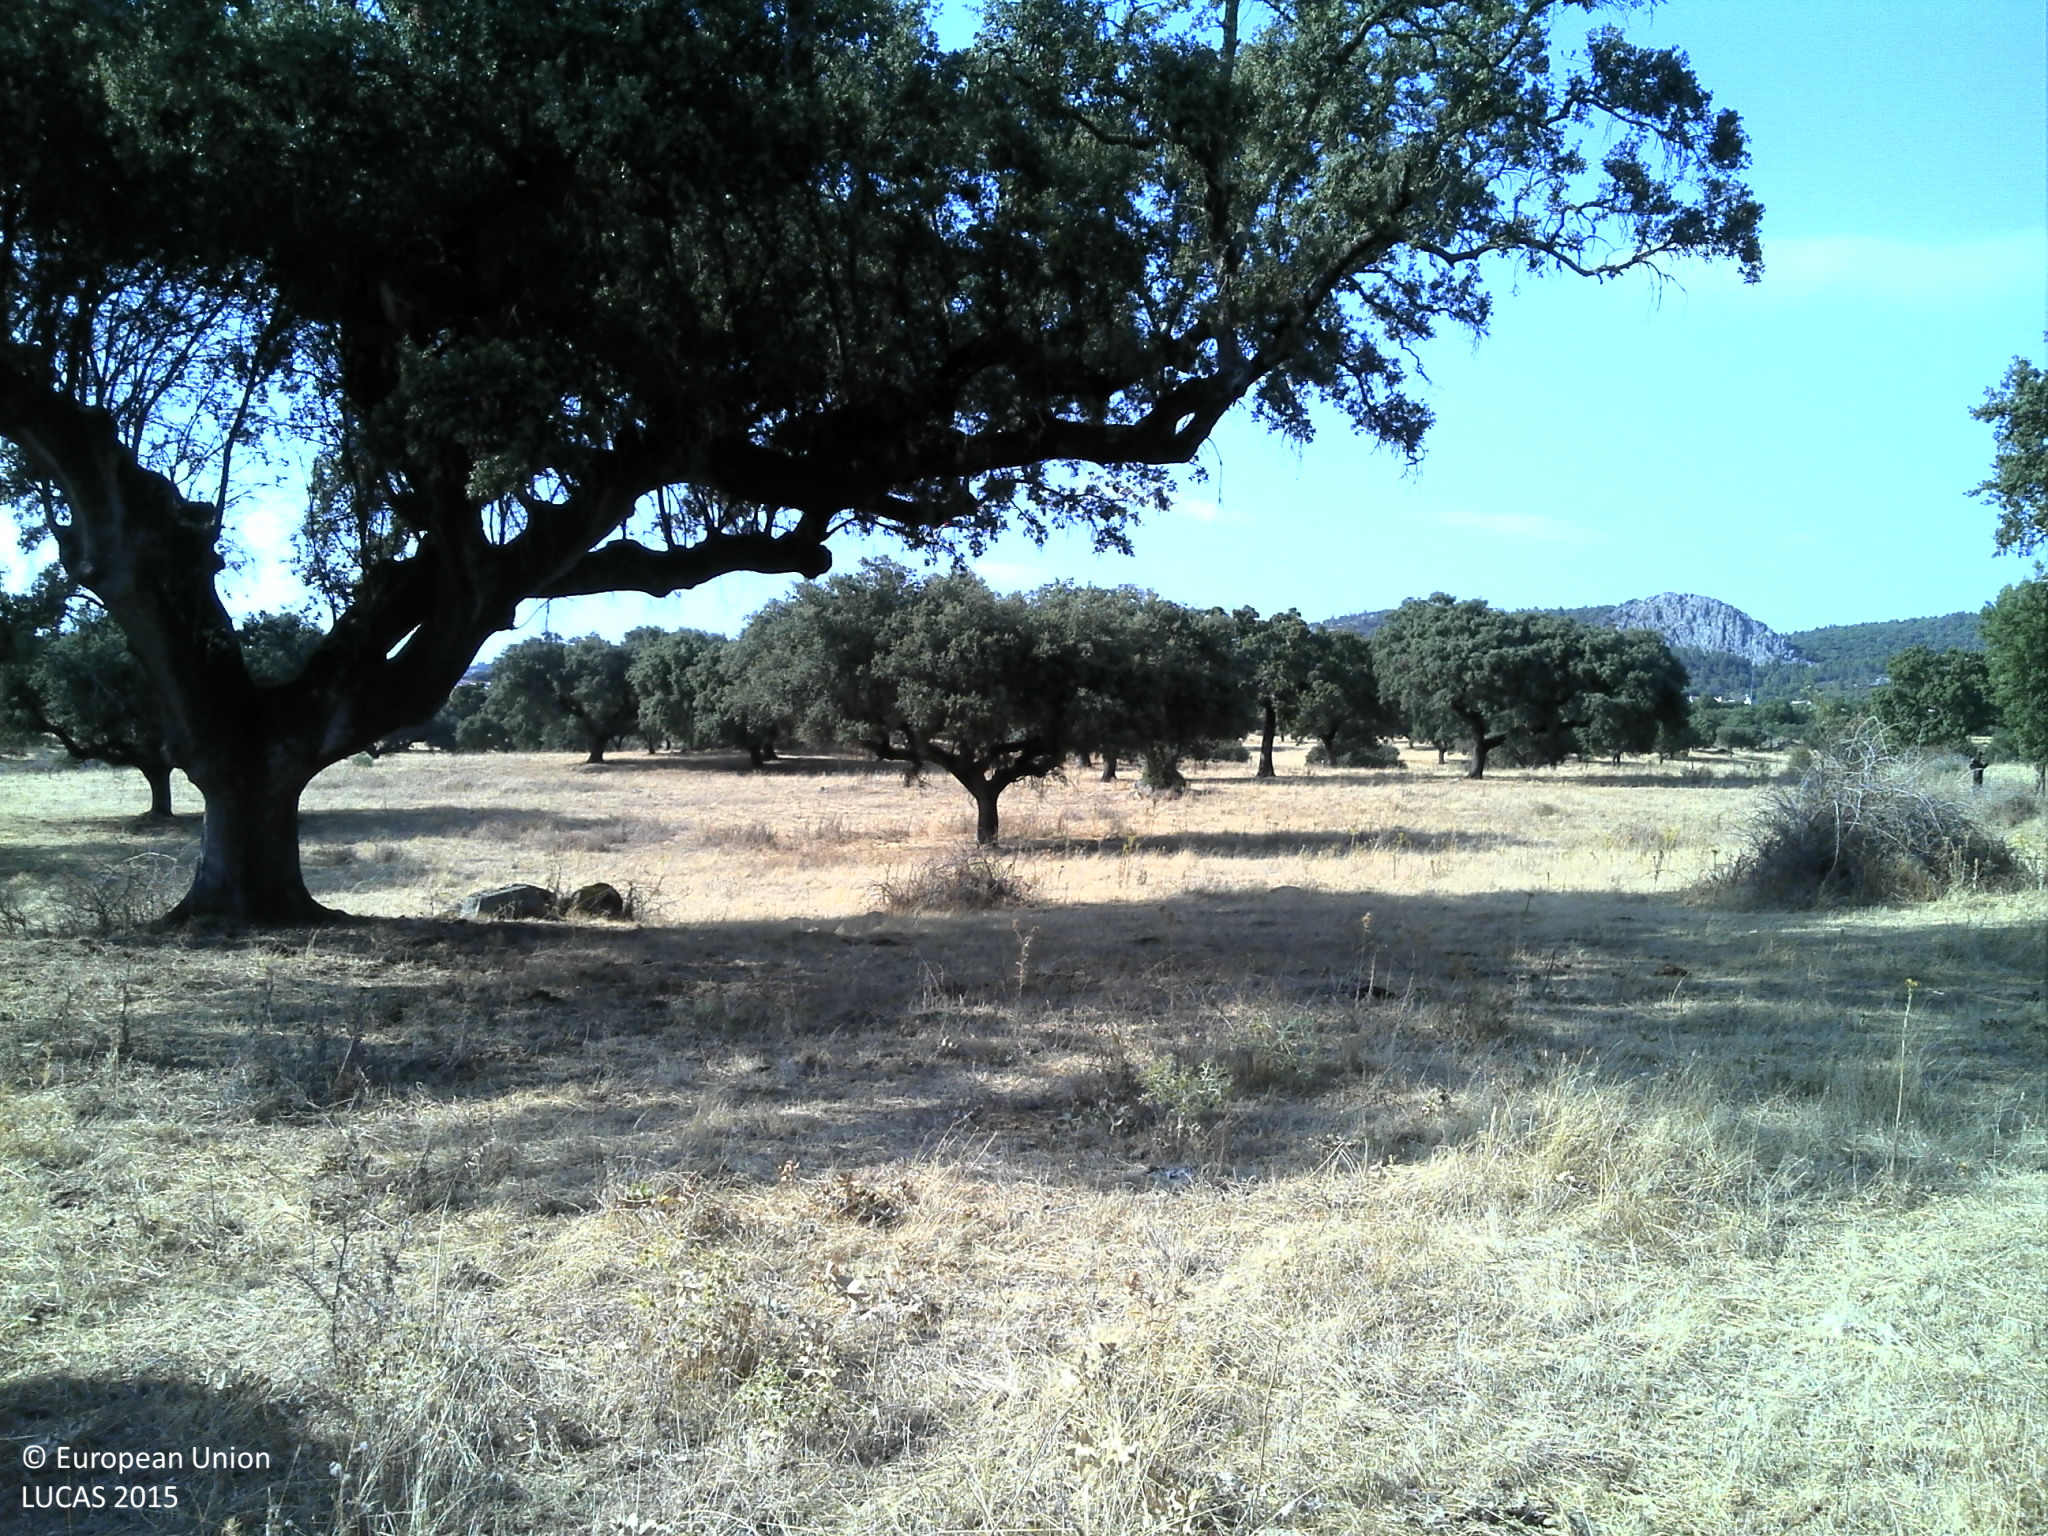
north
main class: Woodland
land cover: Broadleaved woodland
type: broadleaved evergreen forest
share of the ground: 10 - 25 %
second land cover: Grassland without tree/shrub cover
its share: 10 - 25 %
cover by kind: unconsolidated bare surface 70 %, broadleaved forest trees 15 %, herbaceous plants 15 %
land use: Forestry
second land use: Agriculture (excluding fallow land and kitchen gardens)
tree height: > 5 m
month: August
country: PT
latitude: 39.3088
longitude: -7.4972
